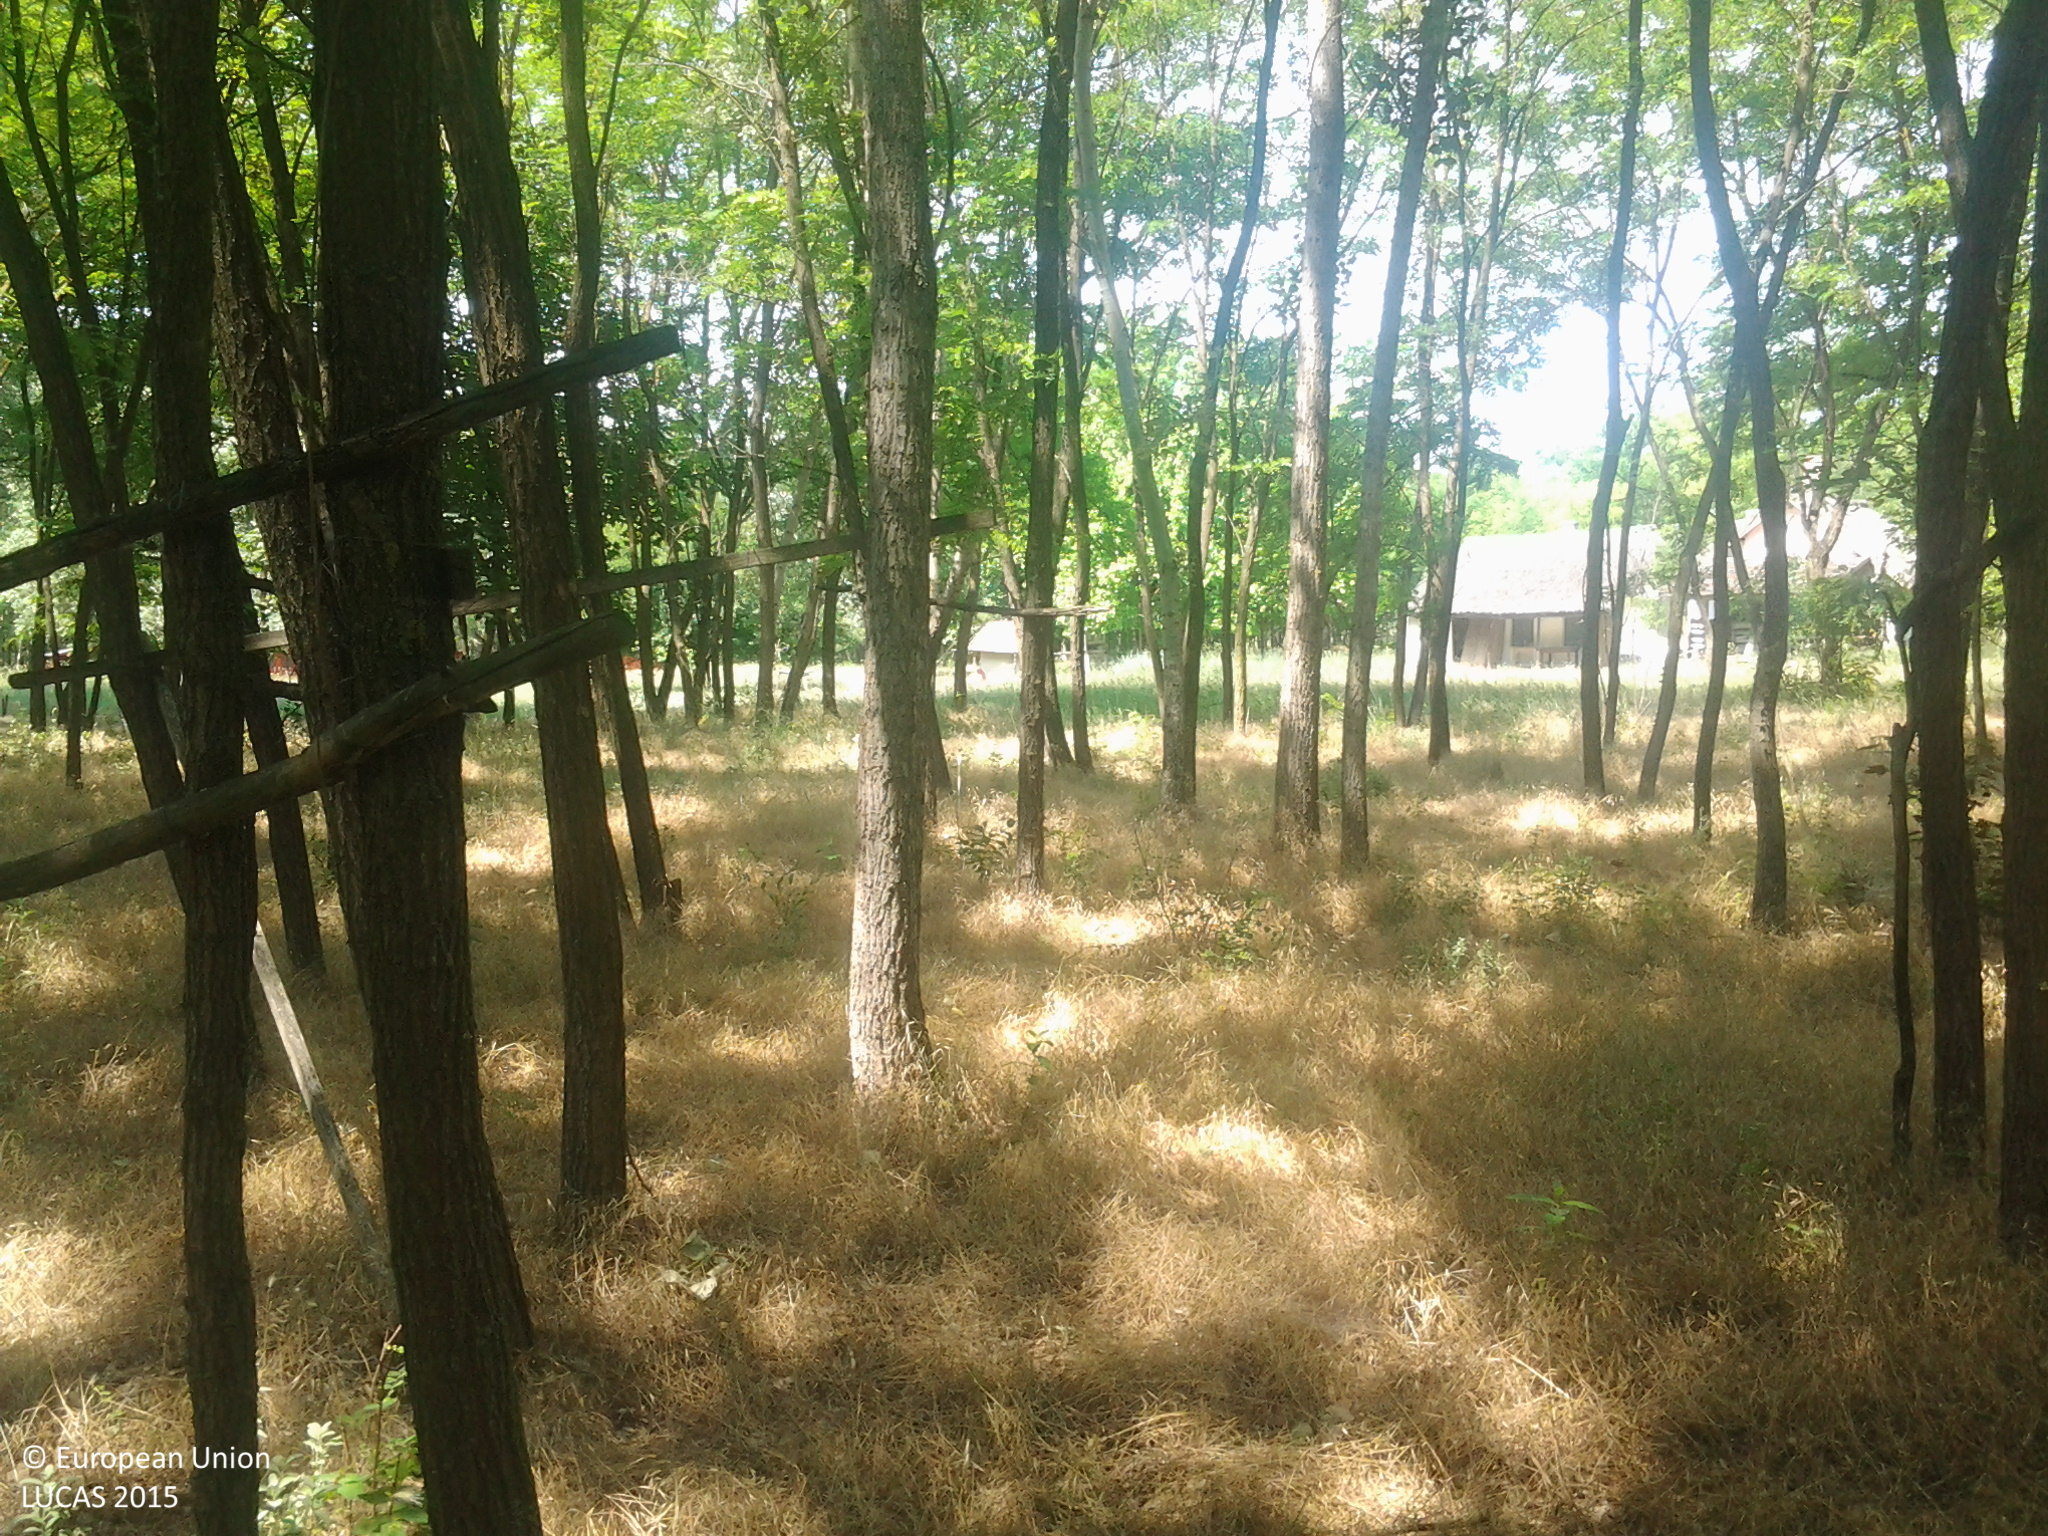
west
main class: Woodland
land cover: Broadleaved woodland
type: mesophytic deciduous forest
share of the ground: > 75 %
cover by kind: broadleaved forest trees 85 %, herbaceous plants 15 %
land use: Forestry
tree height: > 5 m
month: June
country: HU
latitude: 46.7915
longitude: 19.5694
